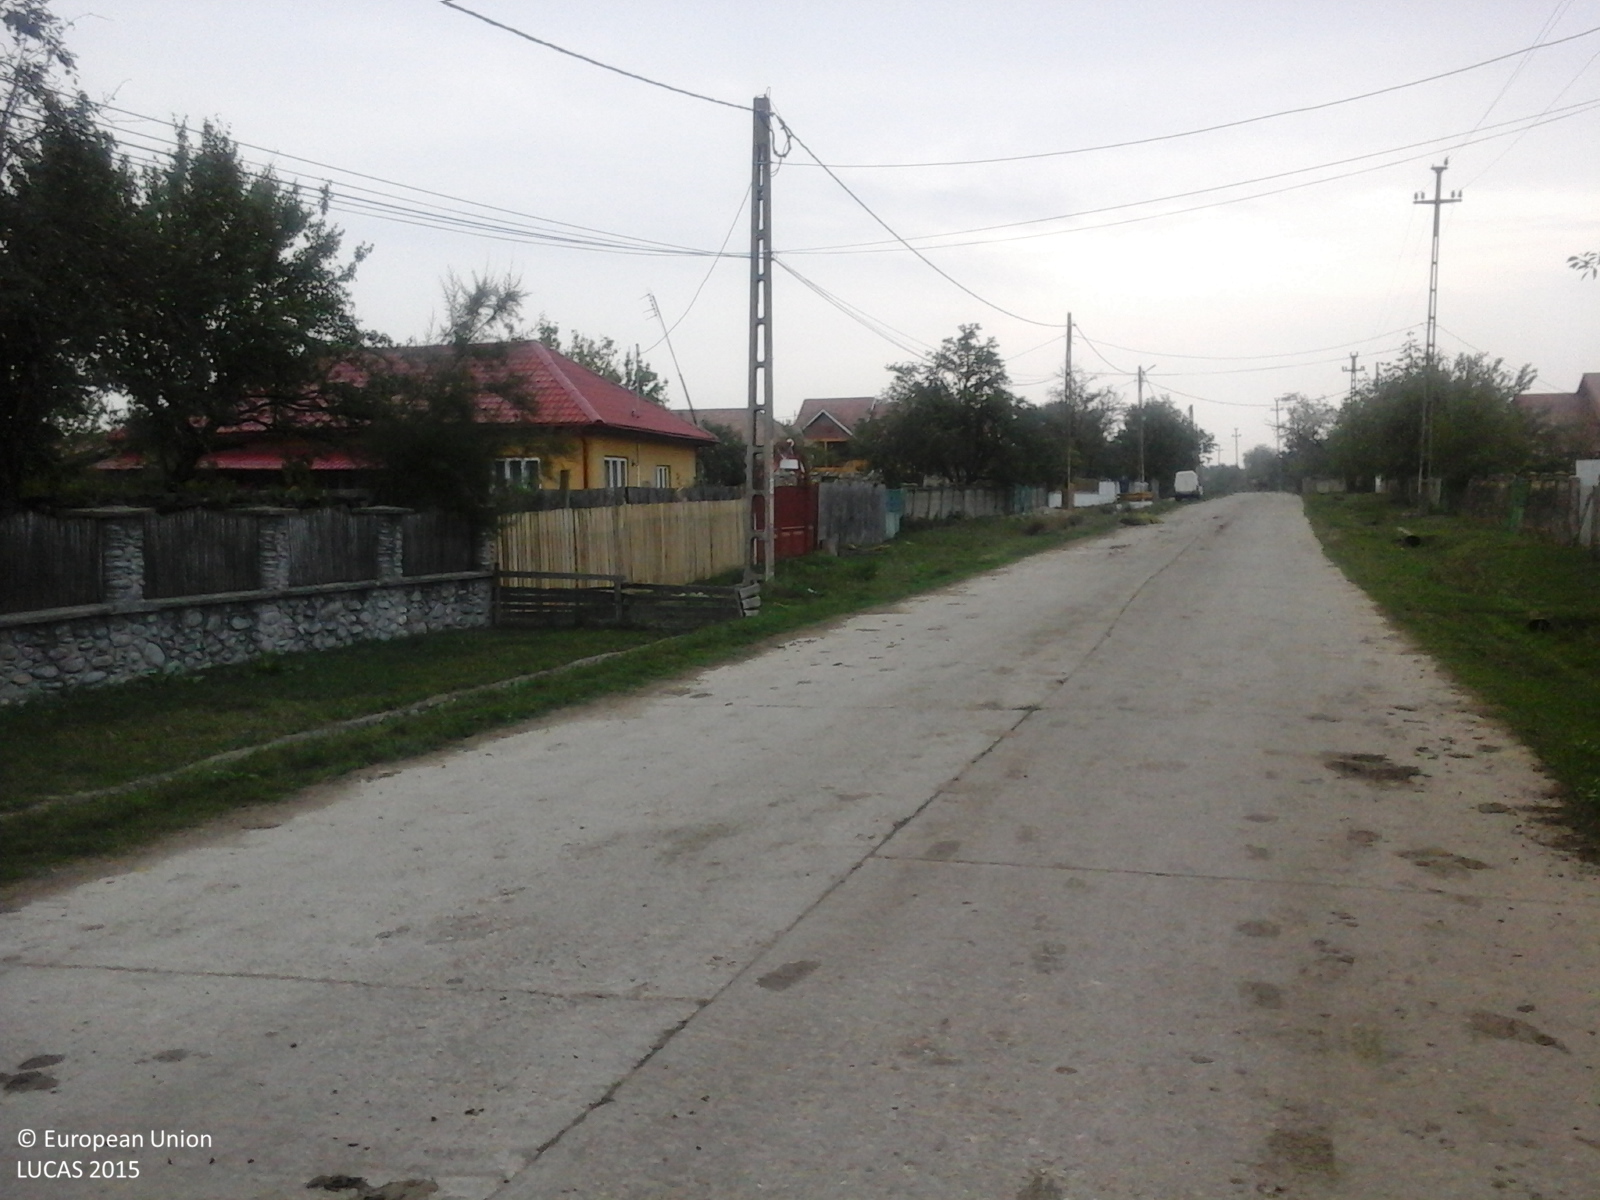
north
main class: Cropland
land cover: Vineyards
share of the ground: > 75 %
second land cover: Grassland without tree/shrub cover
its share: > 75 %
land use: Agriculture (excluding fallow land and kitchen gardens)
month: September
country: RO
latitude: 44.9346
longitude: 23.4239
